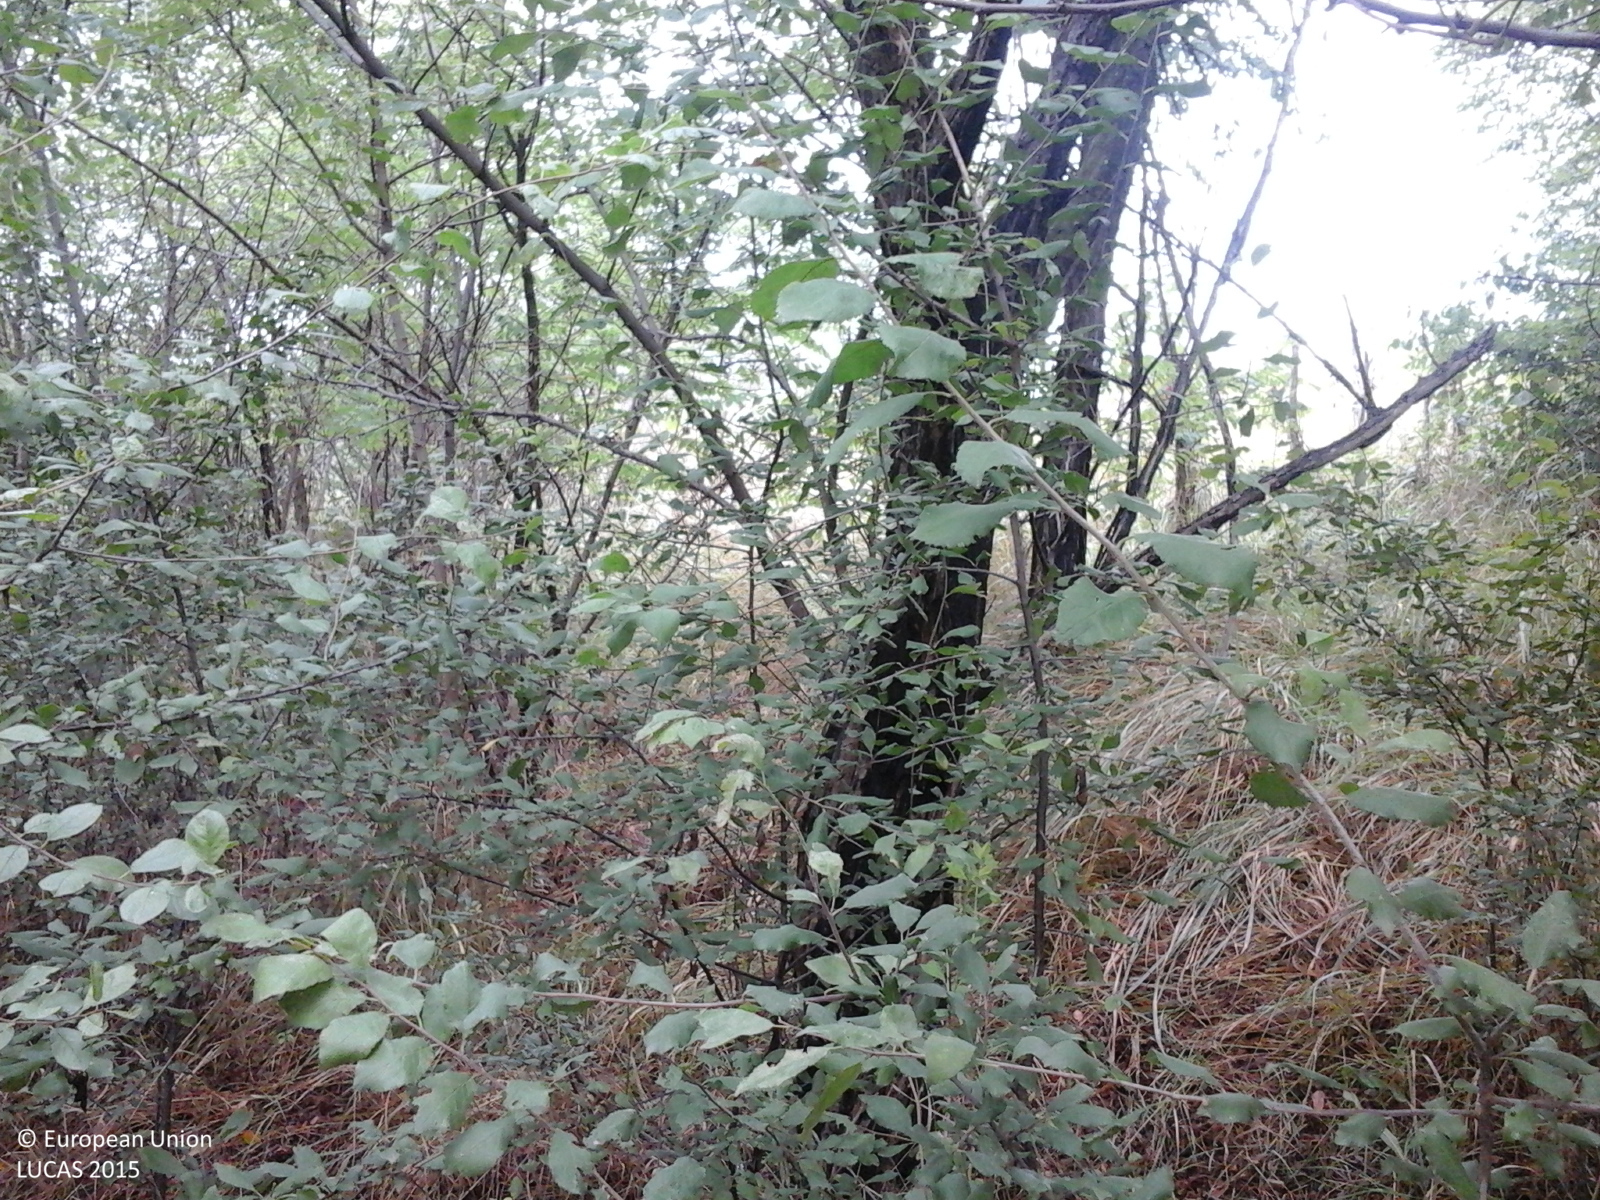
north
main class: Woodland
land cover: Broadleaved woodland
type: exotic forest
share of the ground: > 75 %
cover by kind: broadleaved forest trees 100 %
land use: Forestry
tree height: > 5 m
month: September
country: RO
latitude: 47.1697
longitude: 22.1211
